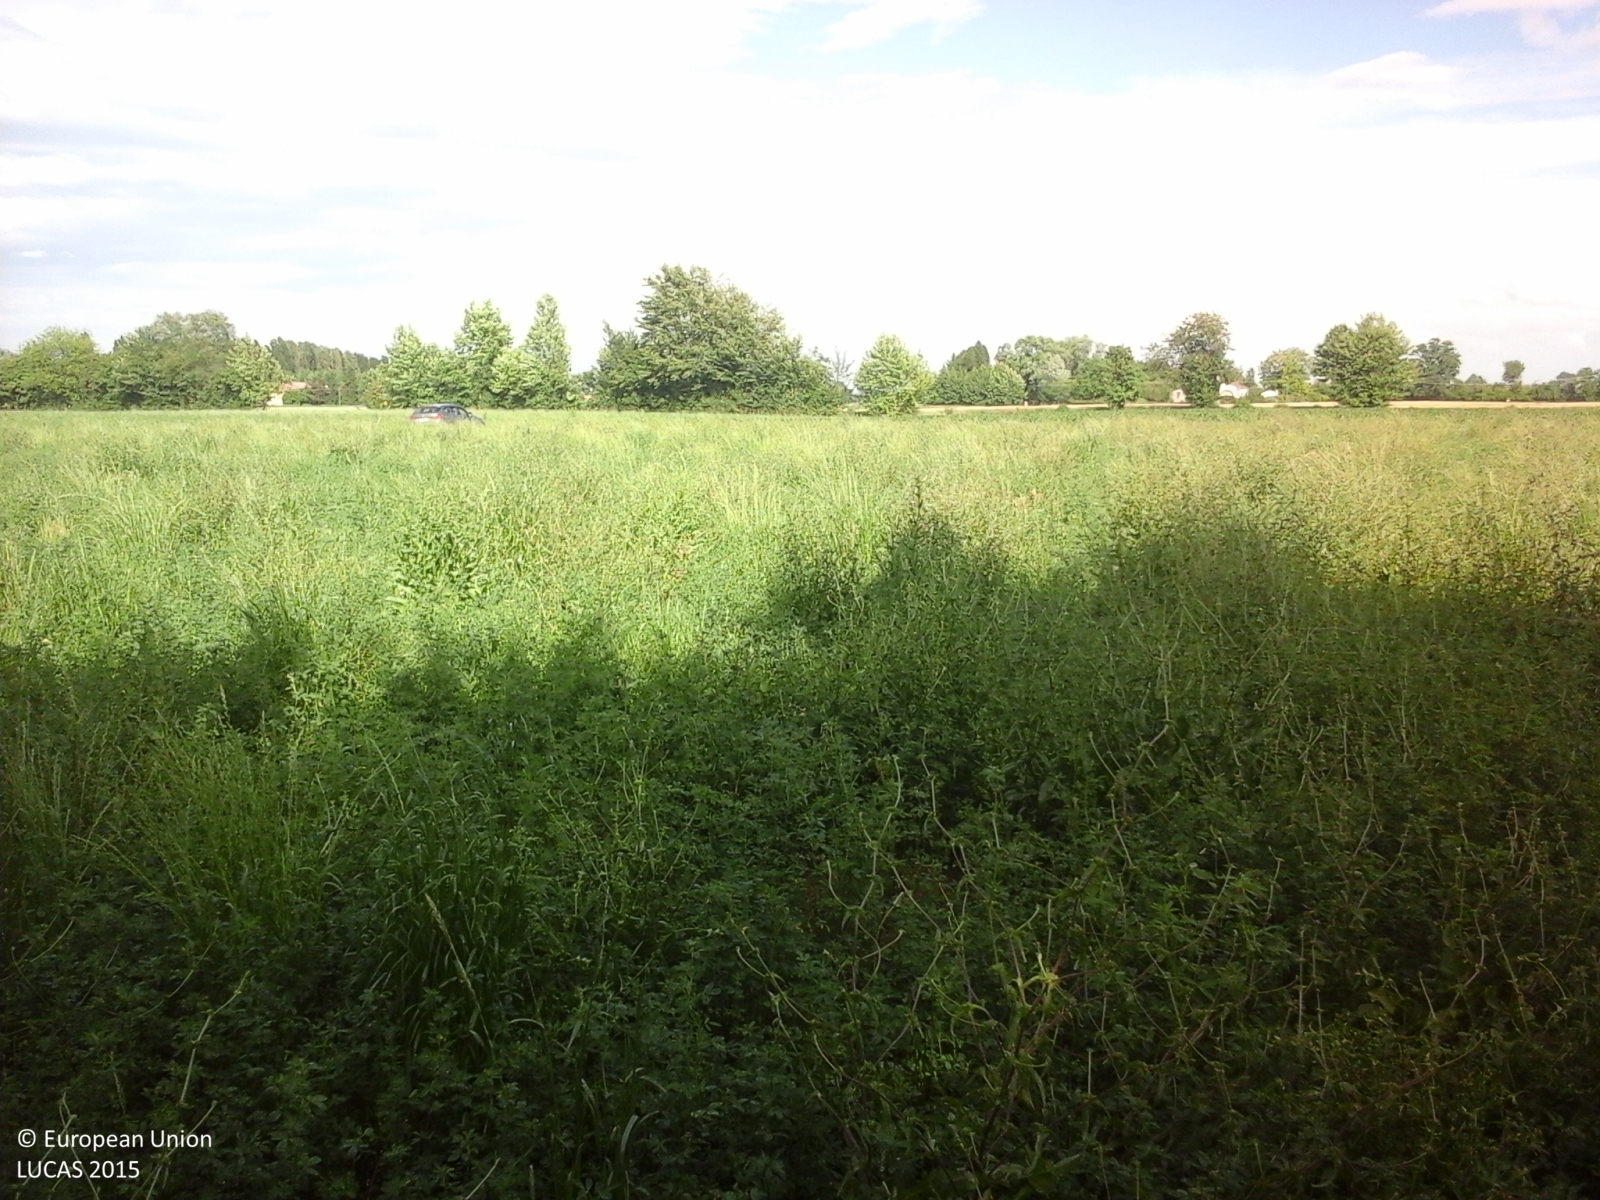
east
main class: Cropland
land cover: Lucerne
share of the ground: > 75 %
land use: Agriculture (excluding fallow land and kitchen gardens)
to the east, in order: Tracks; Lucerne; Maize; Tracks; Lucerne; Tracks; Grass margins; Managed hedges; Ditches and canals; Grass margins; Barley
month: May
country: IT
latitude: 45.1048
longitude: 10.7991
